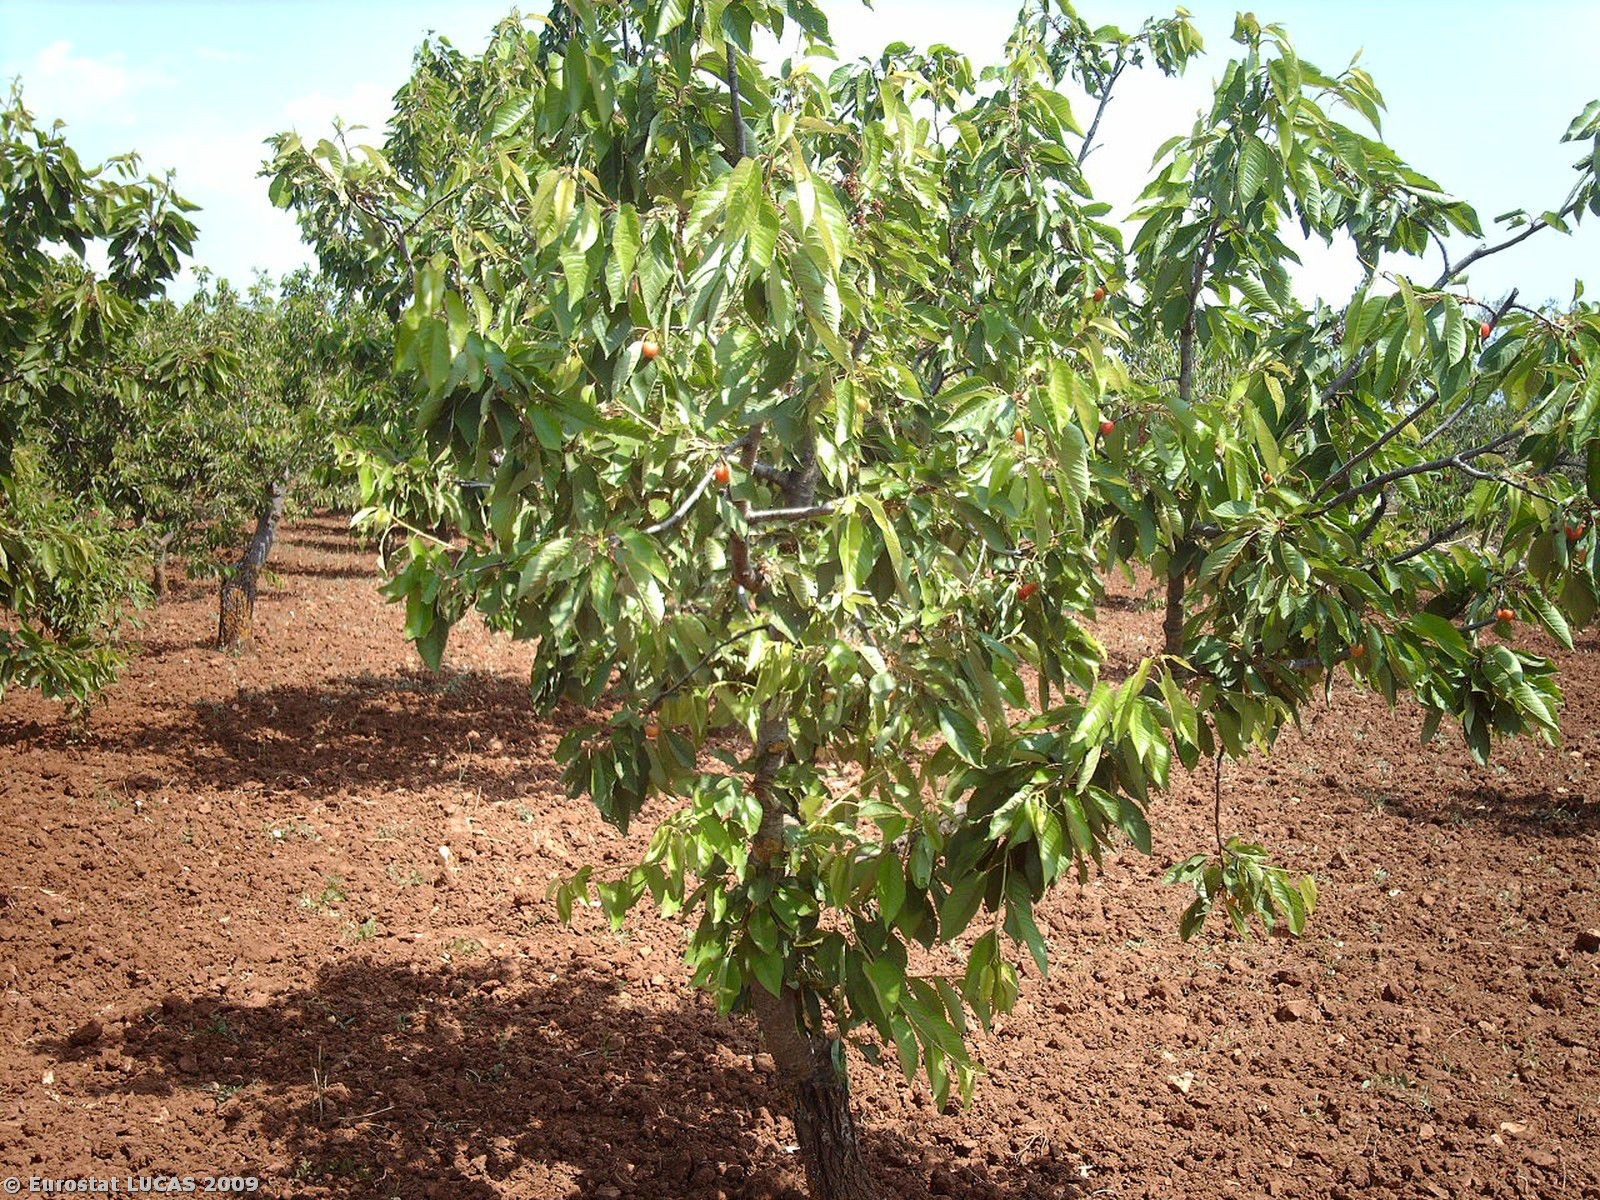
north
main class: Cropland
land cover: Cherry fruit
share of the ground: 50 - 75 %
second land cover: Olive groves
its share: 10 - 25 %
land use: Agriculture (excluding fallow land and kitchen gardens)
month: May
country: IT
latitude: 40.9070
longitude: 16.9944
